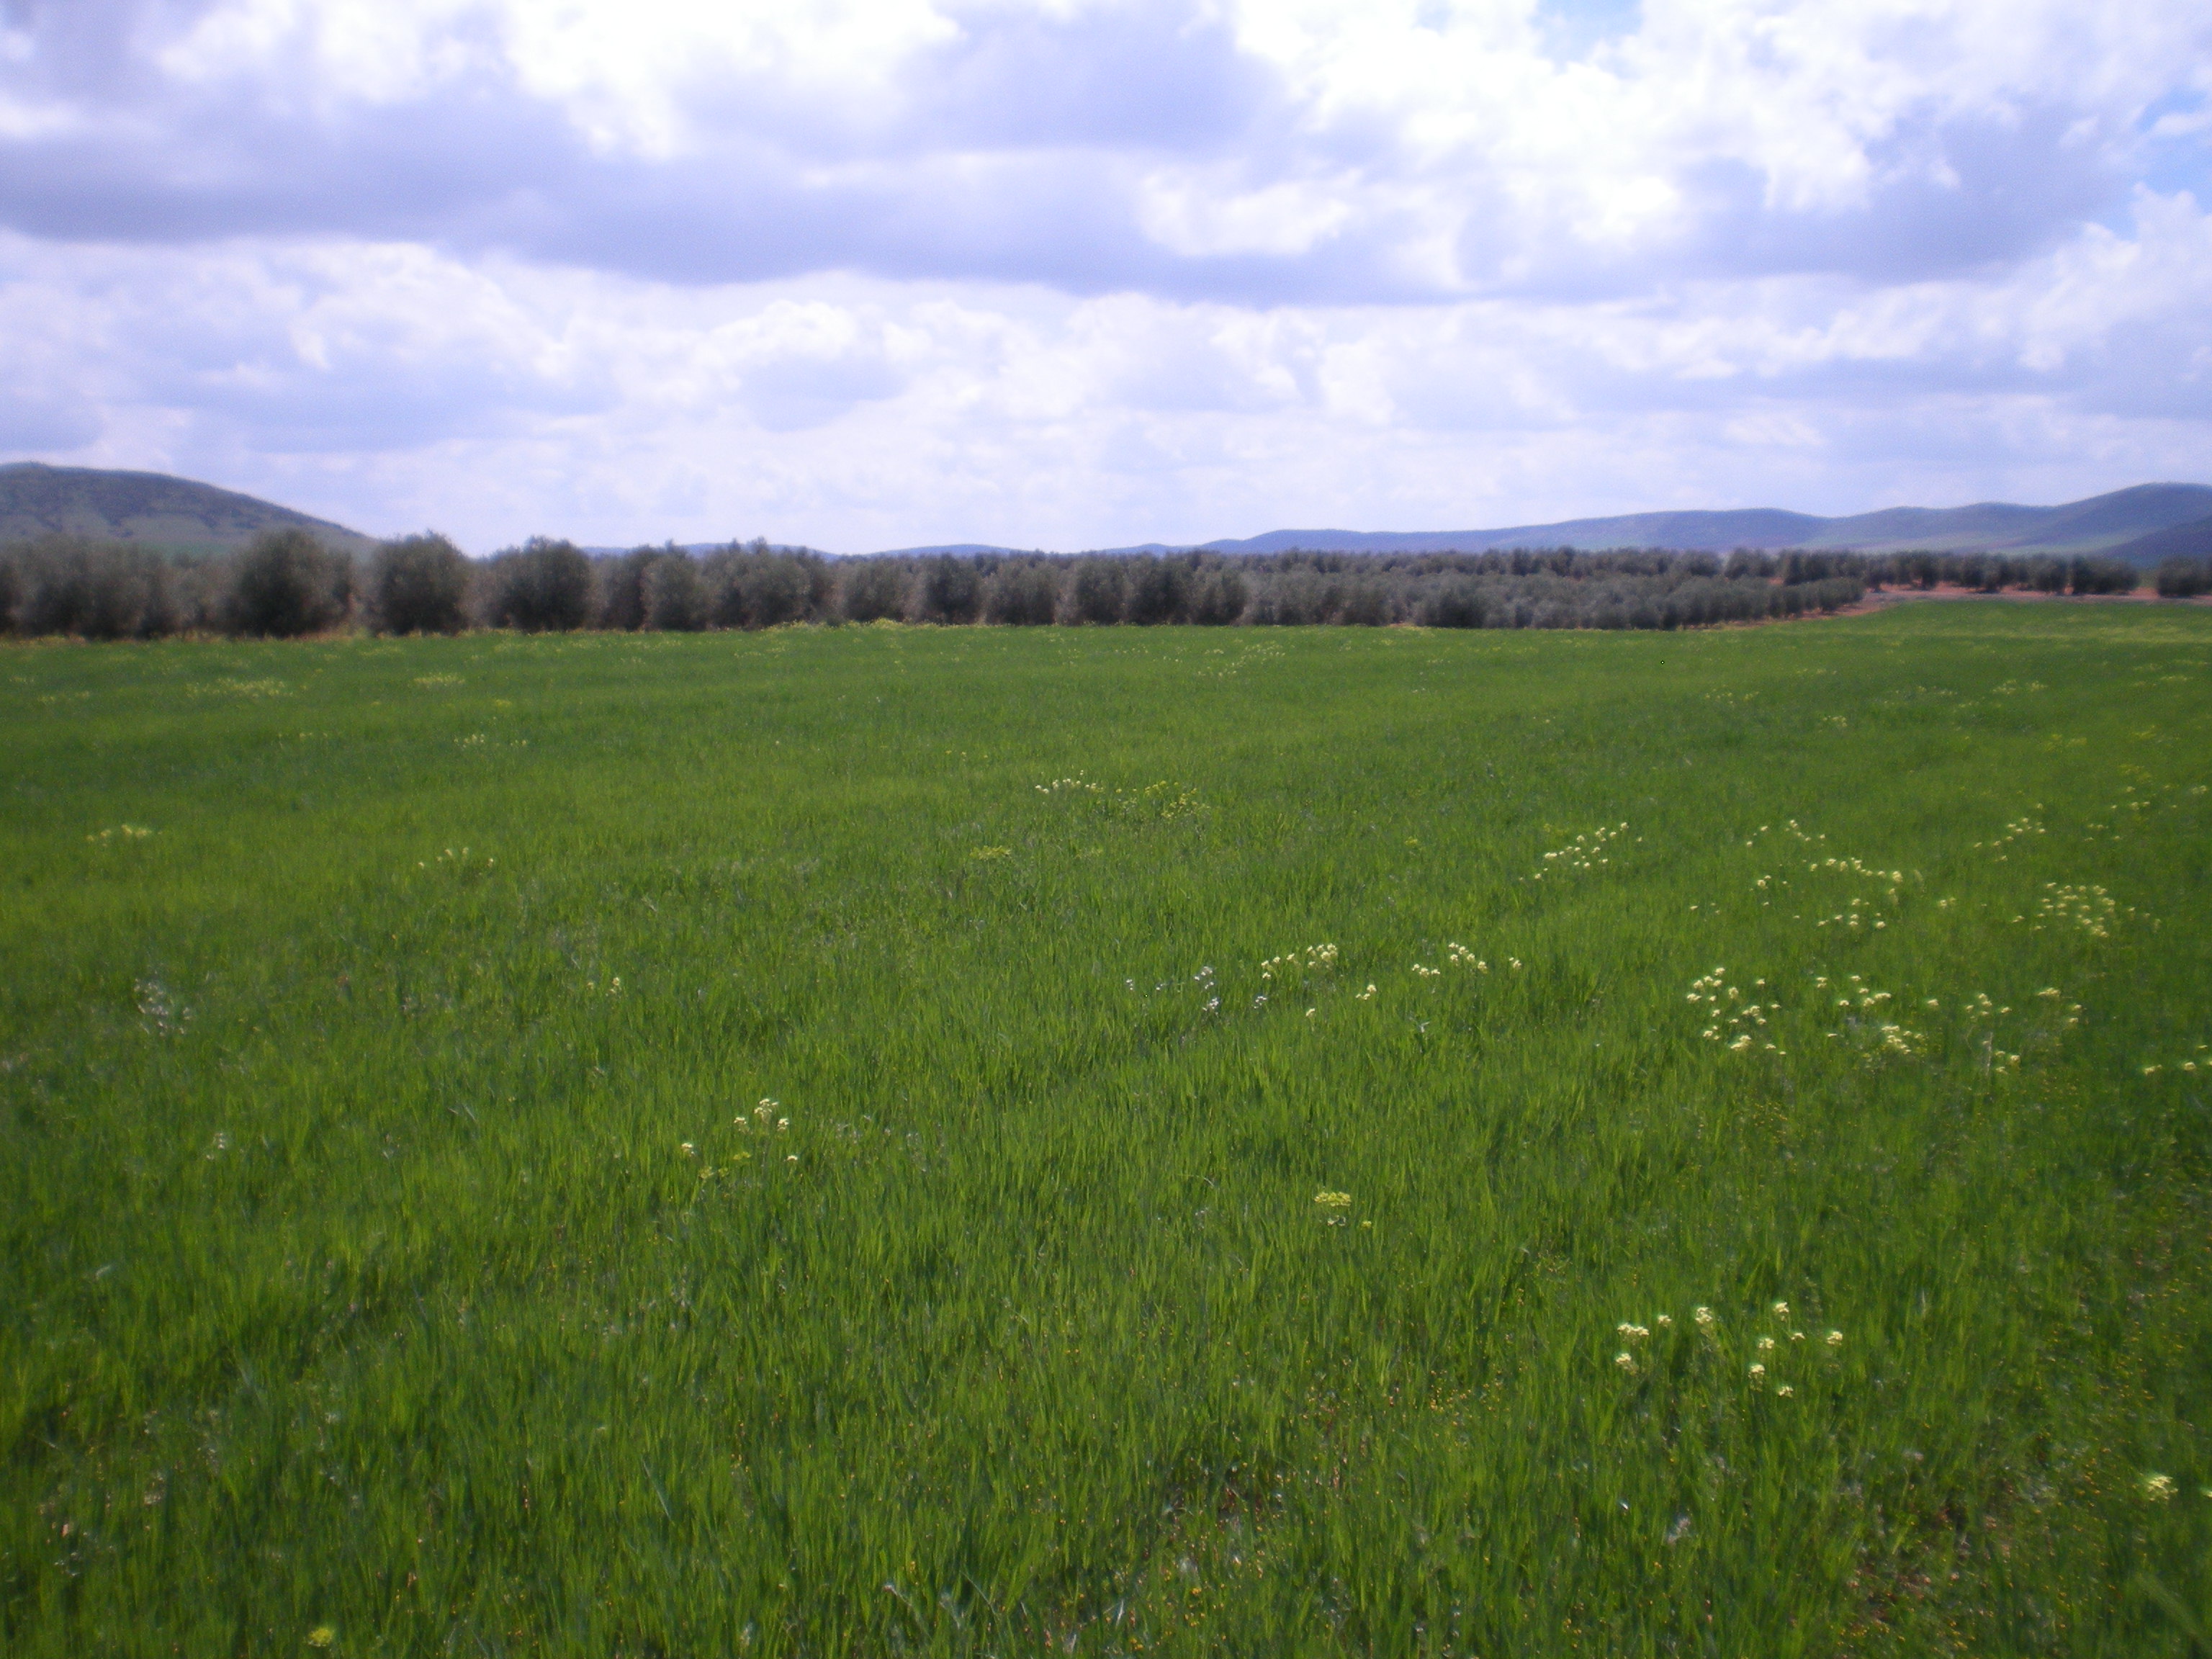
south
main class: Cropland
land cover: Oats
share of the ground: > 75 %
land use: Agriculture (excluding fallow land and kitchen gardens)
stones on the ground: 25 - 50 %
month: April
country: ES
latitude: 38.7033
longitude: -3.5227
